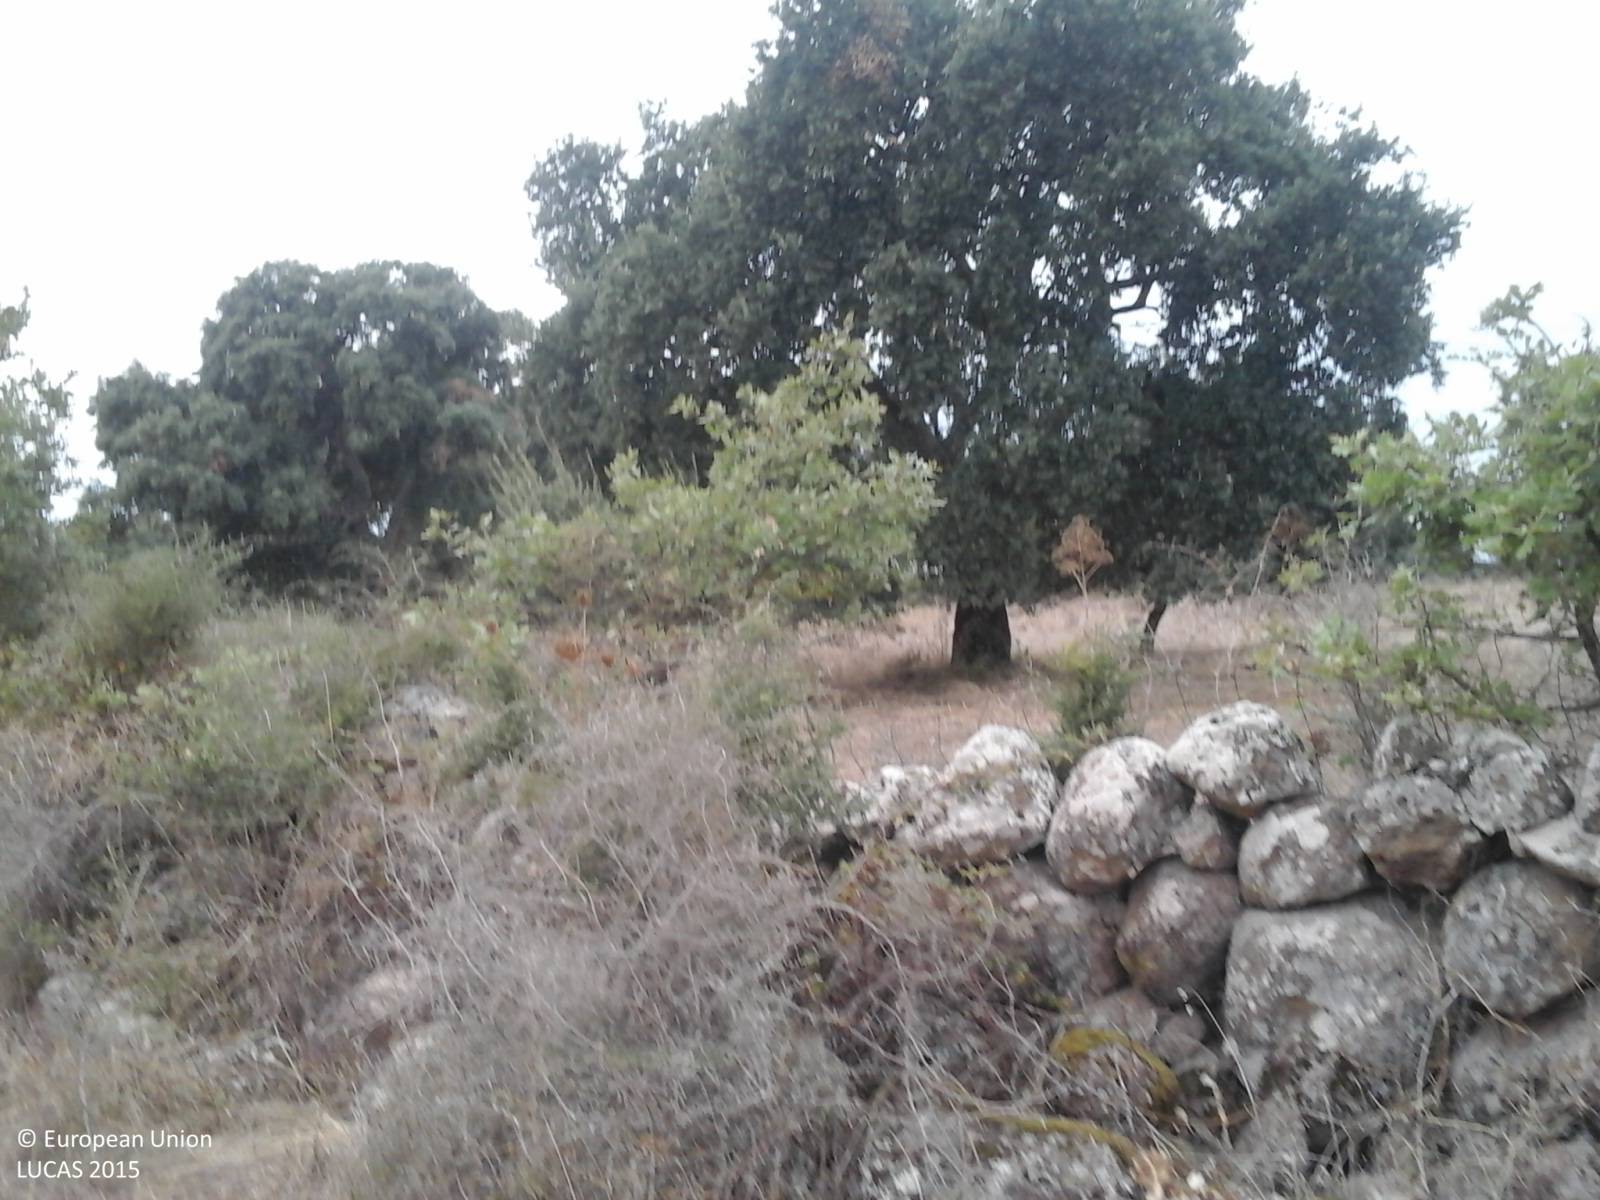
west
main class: Grassland
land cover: Grassland with sparse tree/shrub cover
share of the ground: > 75 %
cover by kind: herbaceous plants 95 %, broadleaved forest trees 5 %
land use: Agriculture (excluding fallow land and kitchen gardens)
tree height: < 5 m
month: September
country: IT
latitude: 40.1694
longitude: 8.7969
